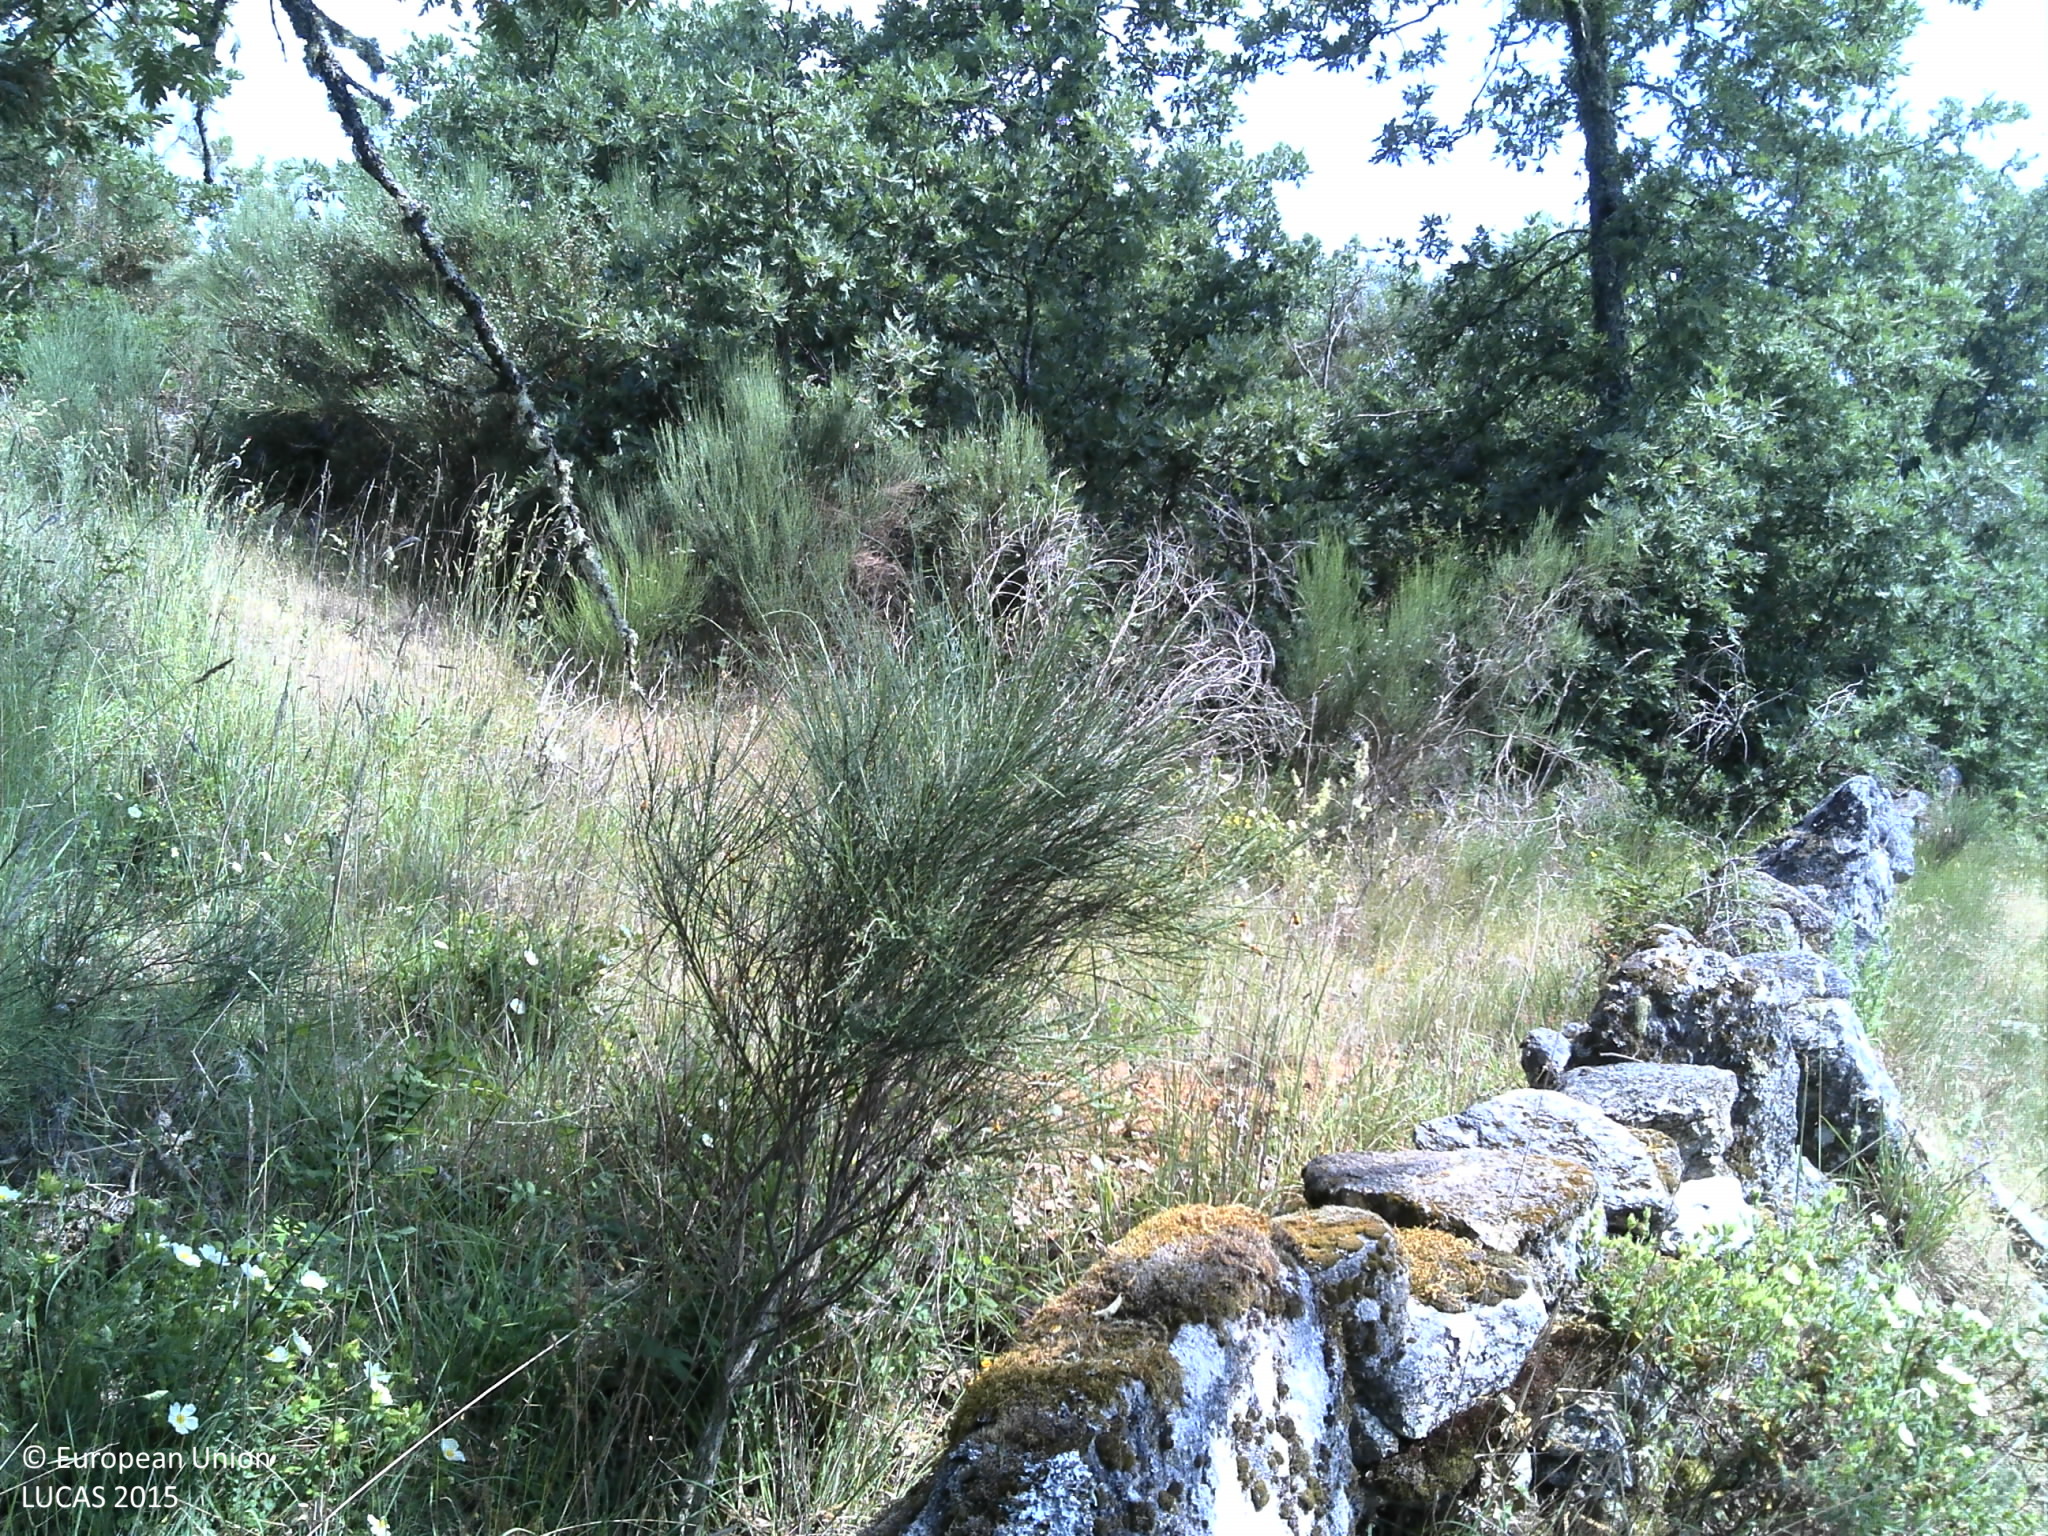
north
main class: Woodland
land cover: Broadleaved woodland
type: thermophilous deciduous forest
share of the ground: 50 - 75 %
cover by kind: broadleaved forest trees 50 %, shrubs 20 %, herbaceous plants 20 %, unconsolidated bare surface 10 %
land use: Abandoned areas
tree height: > 5 m
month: June
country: PT
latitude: 41.4542
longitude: -7.5702
